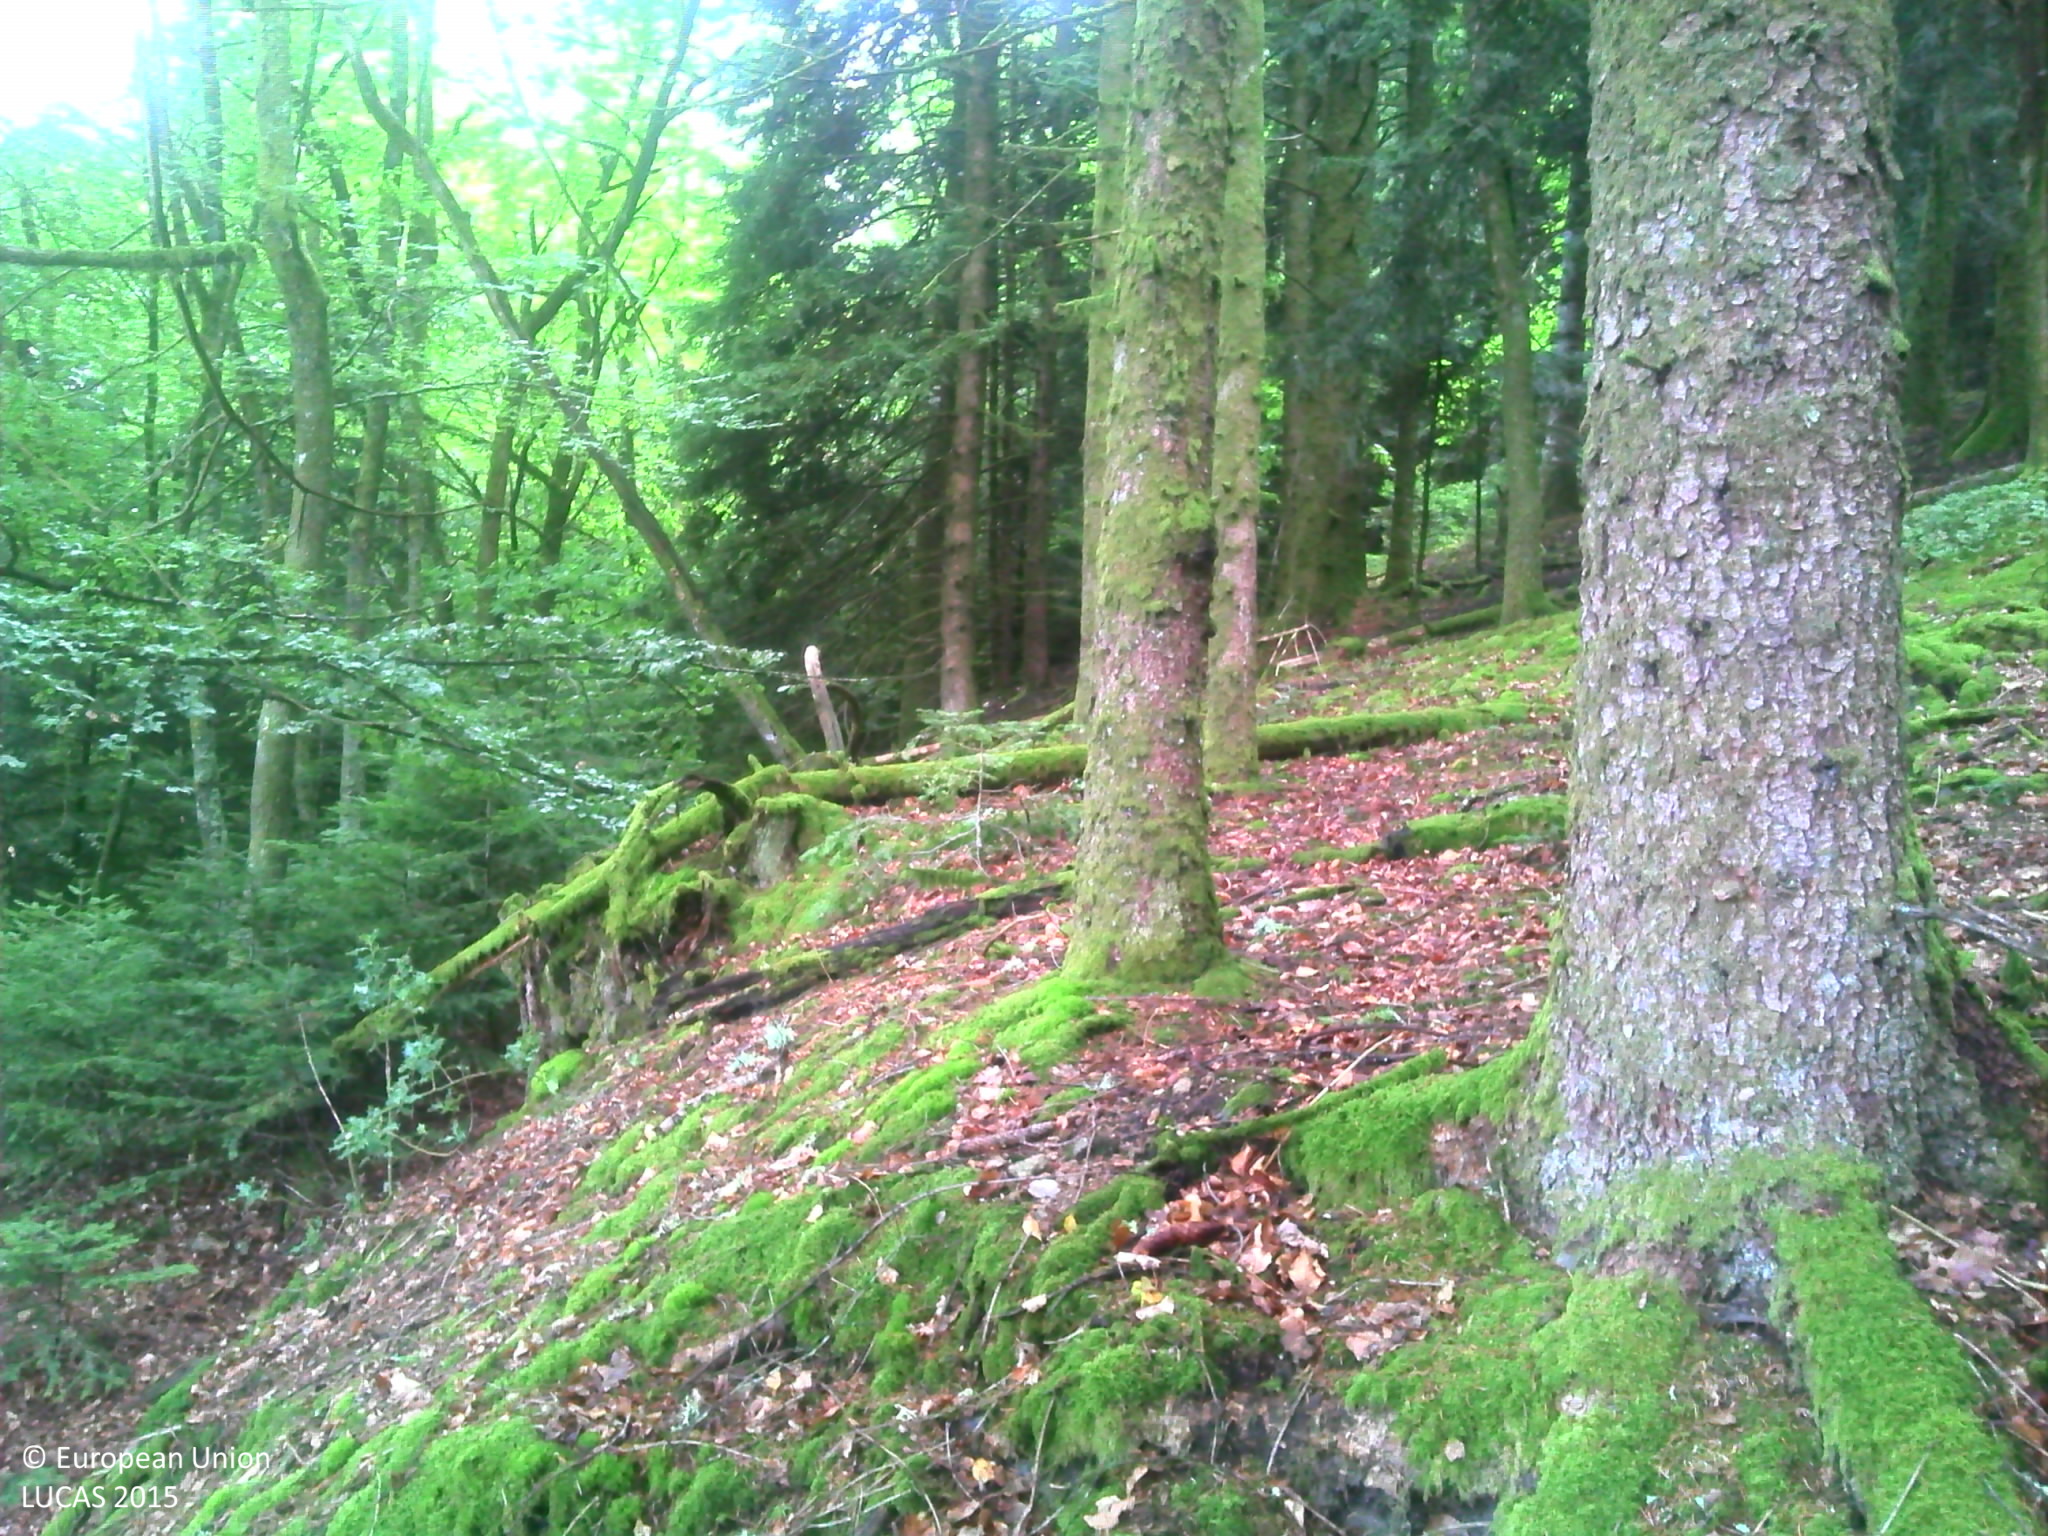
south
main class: Woodland
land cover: Pine dominated mixed woodland
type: mountainous beech forest
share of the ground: 50 - 75 %
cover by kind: coniferous forest trees 40 %, broadleaved forest trees 30 %, herbaceous plants 20 %, lichens and mosses 10 %
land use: Forestry
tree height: > 5 m
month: August
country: FR
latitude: 45.4625
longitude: 1.8747
